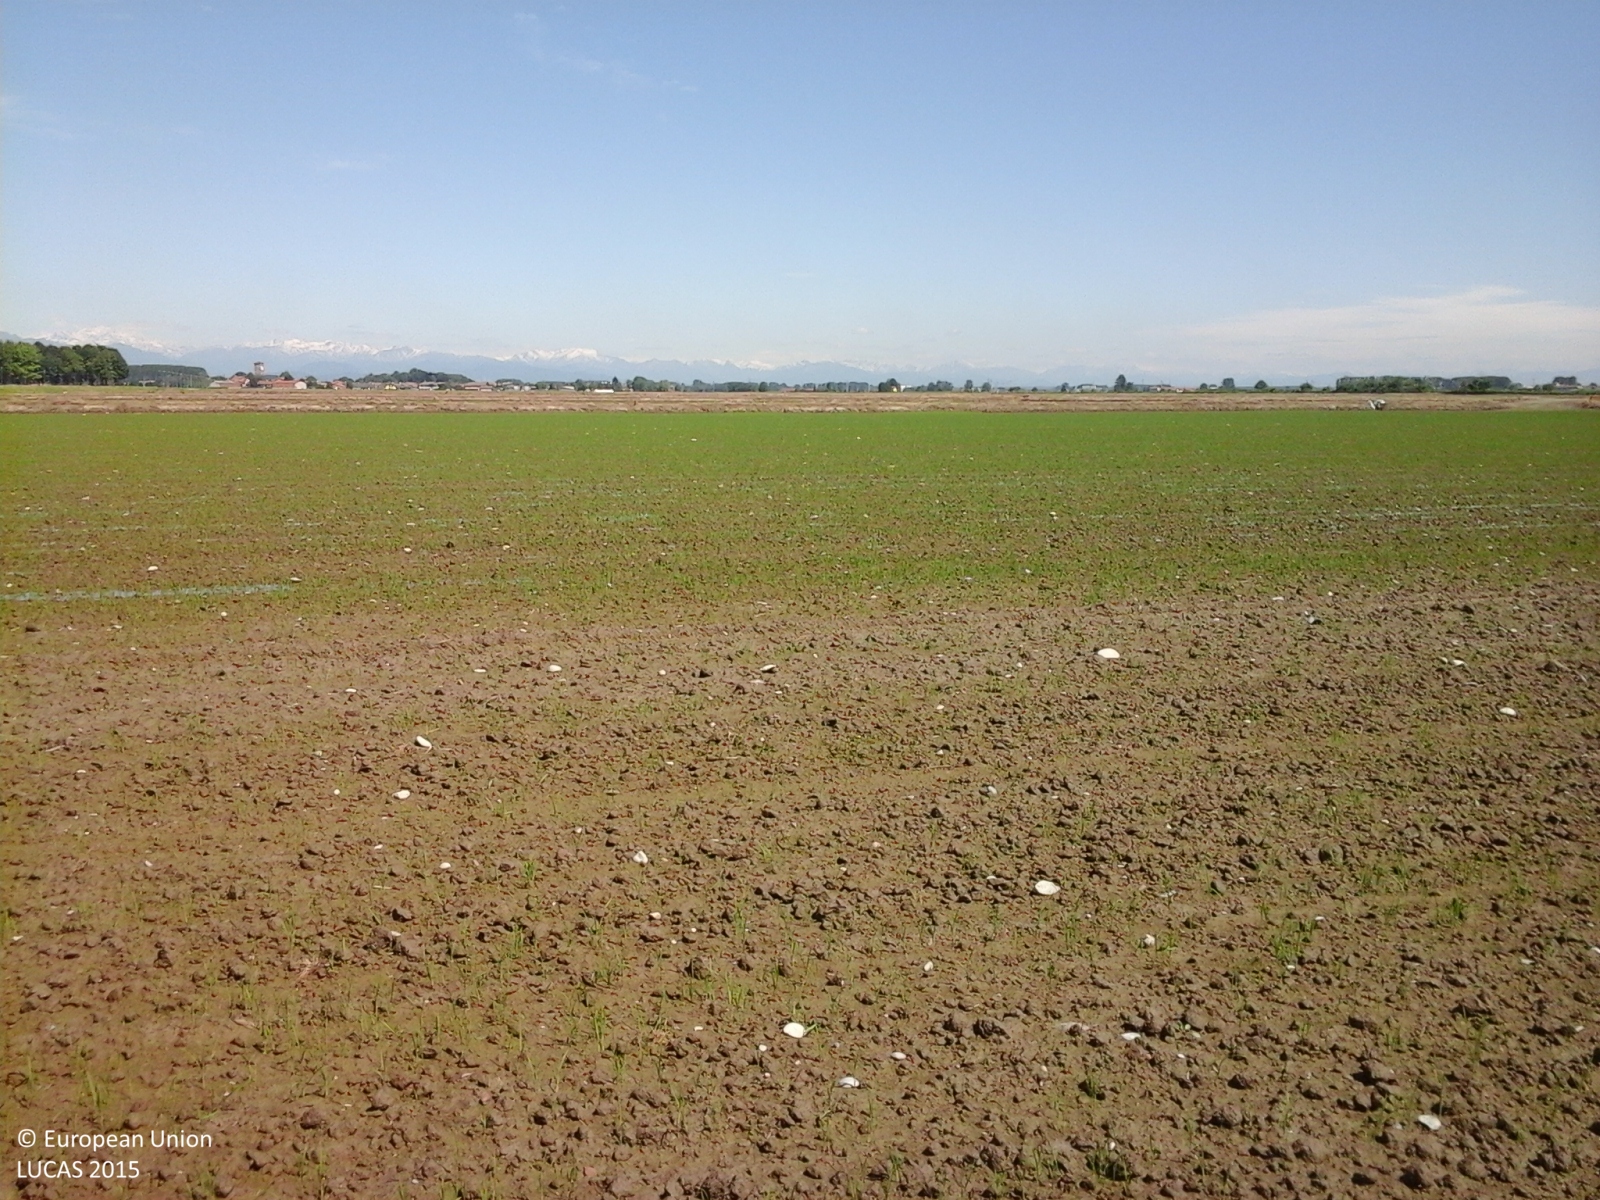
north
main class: Cropland
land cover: Rice
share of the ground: < 10 %
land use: Agriculture (excluding fallow land and kitchen gardens)
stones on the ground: < 10 %
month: May
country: IT
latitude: 45.4207
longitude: 8.4307
